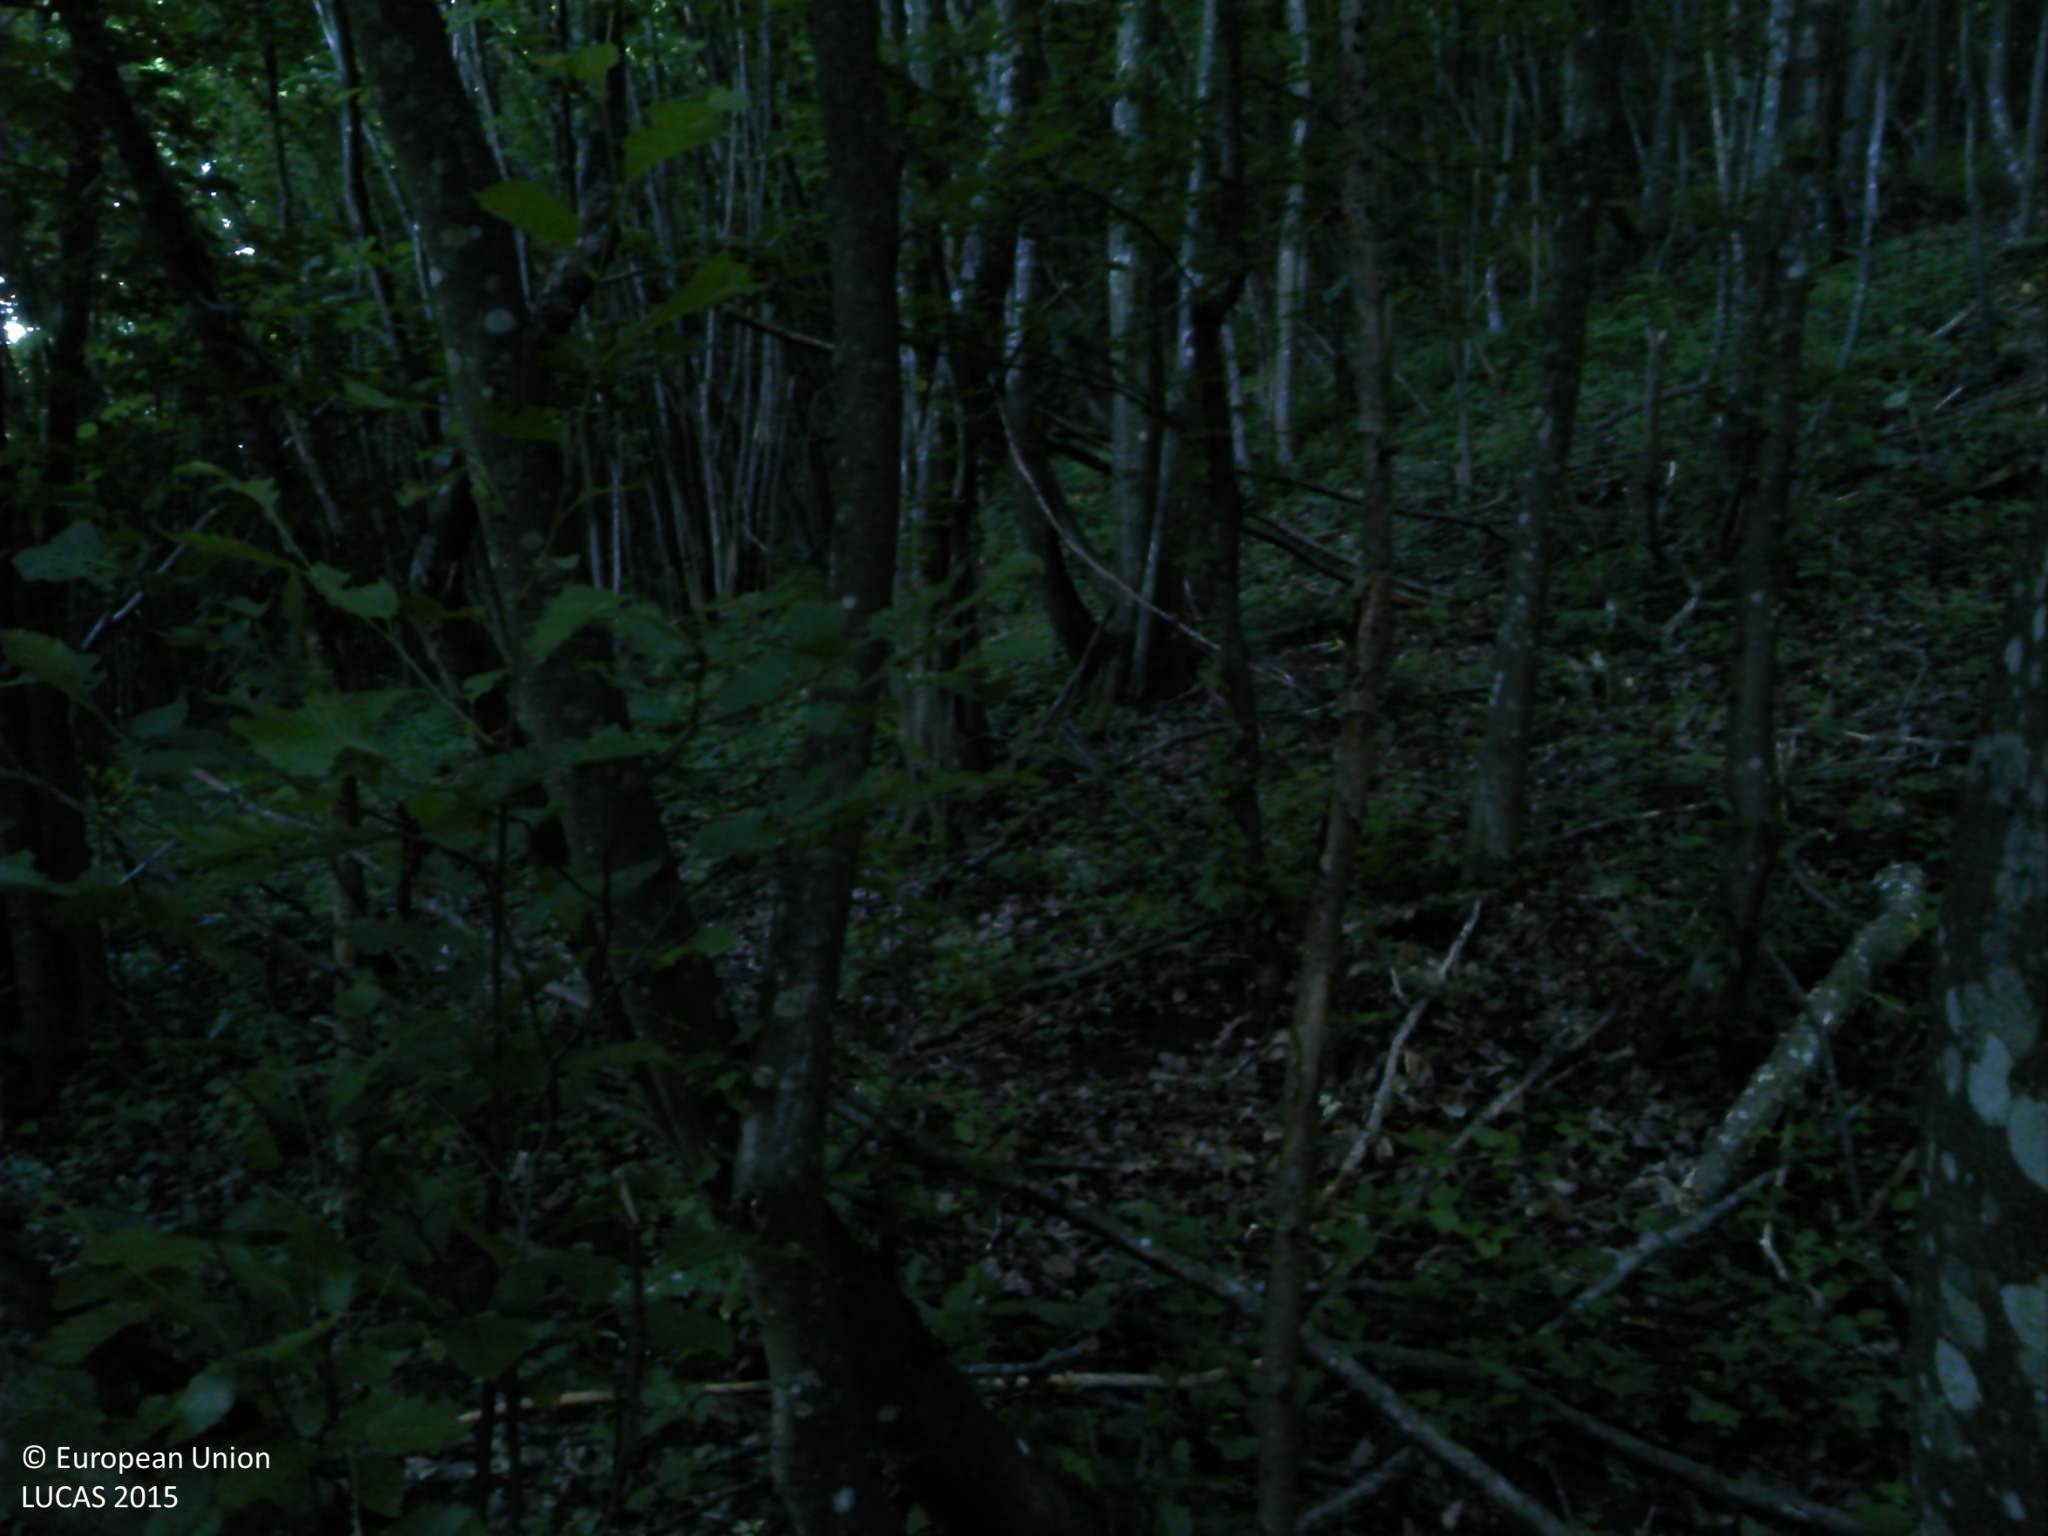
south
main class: Woodland
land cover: Broadleaved woodland
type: beech forest
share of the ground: > 75 %
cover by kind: broadleaved forest trees 100 %
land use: Forestry
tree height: < 5 m
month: May
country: HR
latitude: 45.3270
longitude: 18.0027
